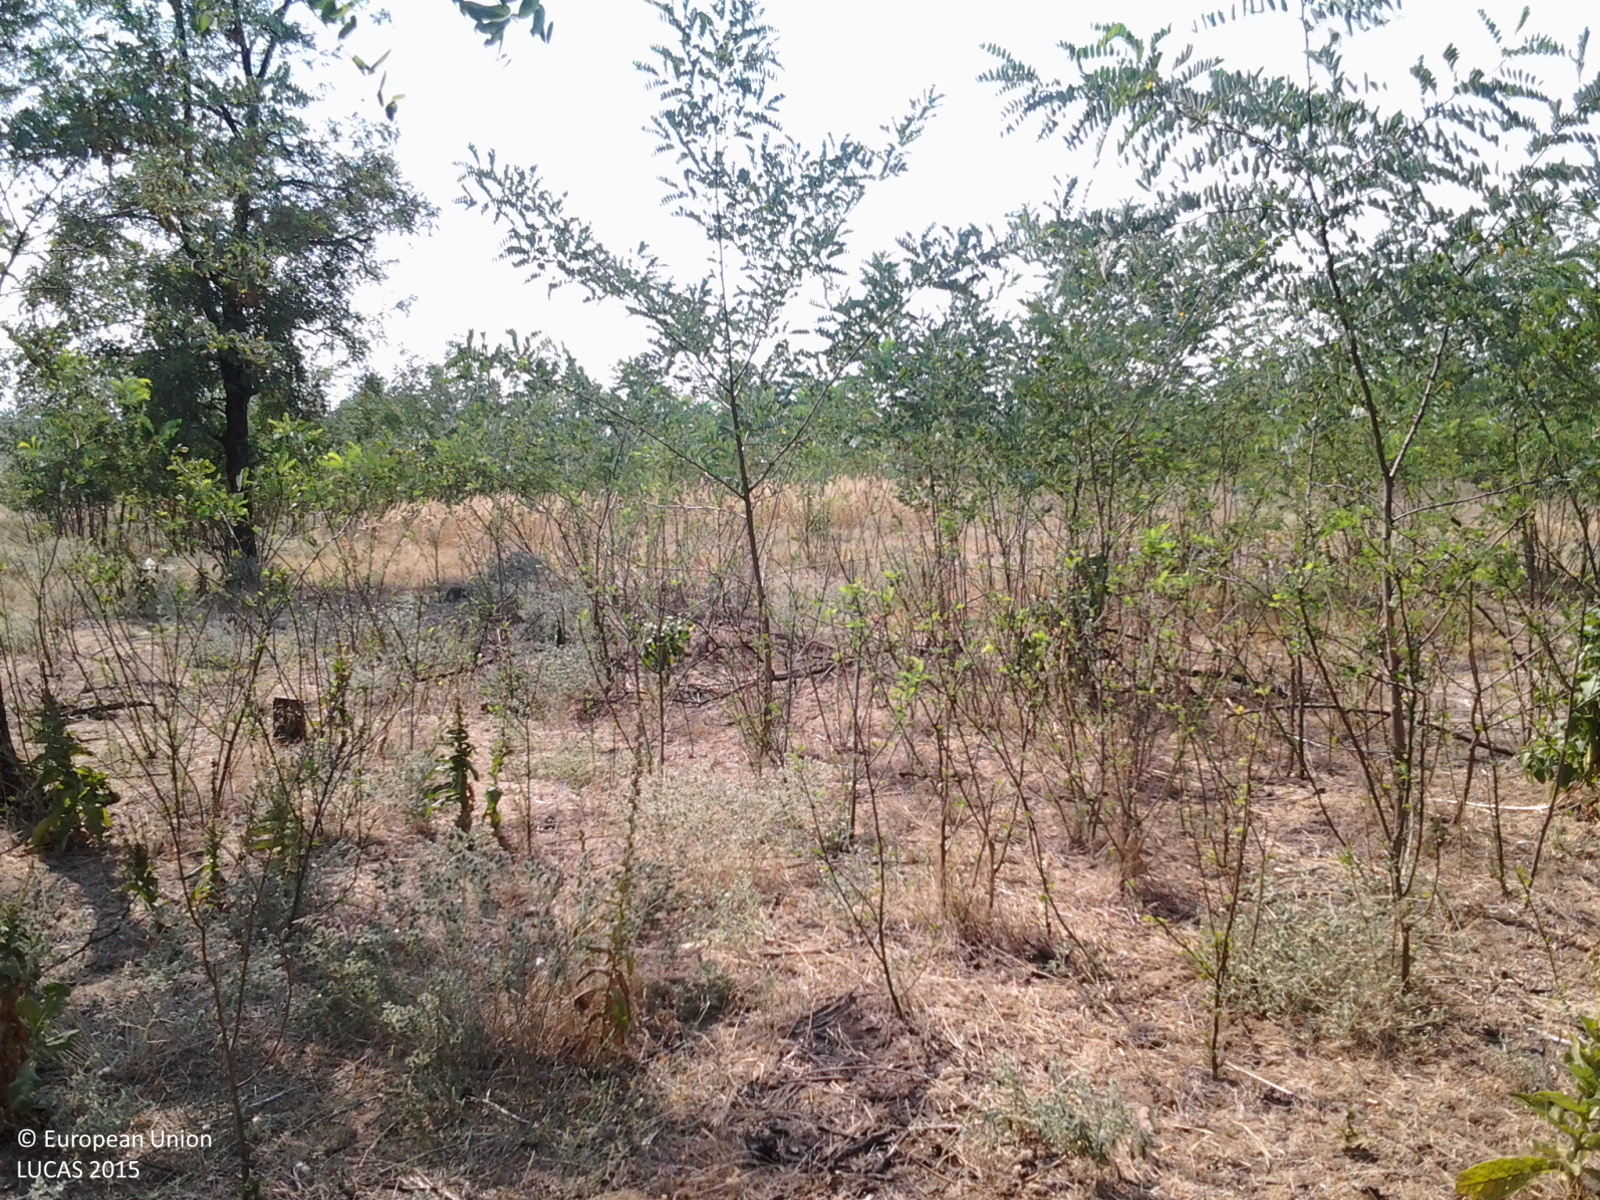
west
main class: Woodland
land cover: Broadleaved woodland
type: exotic forest
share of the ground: > 75 %
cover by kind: broadleaved forest trees 100 %
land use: Forestry
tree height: > 5 m
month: August
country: RO
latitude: 43.8668
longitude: 23.0692
